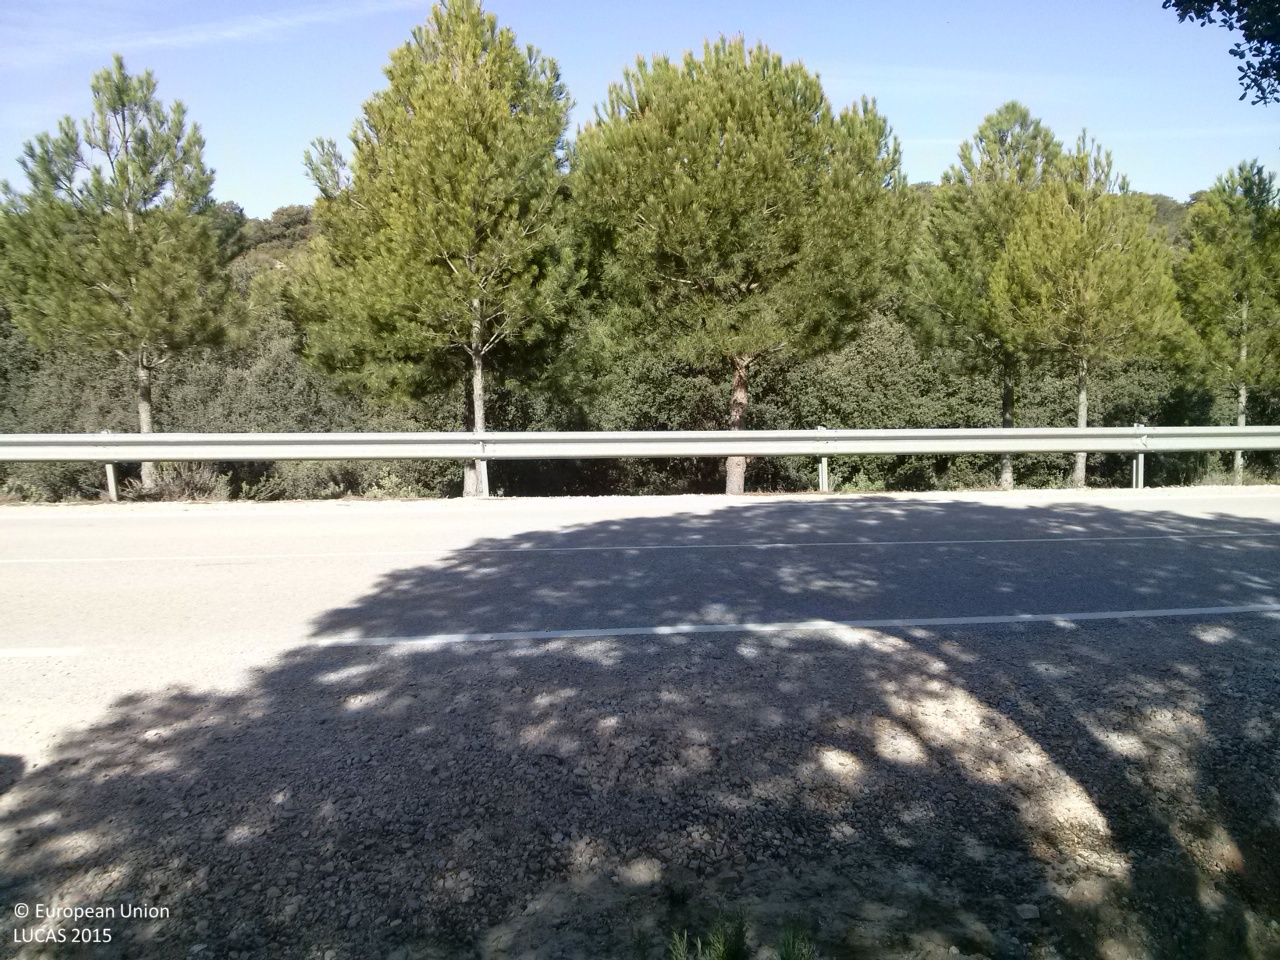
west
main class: Woodland
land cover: Broadleaved woodland
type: broadleaved evergreen forest
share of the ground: 10 - 25 %
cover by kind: shrubs 50 %, broadleaved forest trees 25 %, unconsolidated bare surface 25 %
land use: Forestry
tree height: > 5 m
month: May
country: ES
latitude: 39.8676
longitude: -2.7741
